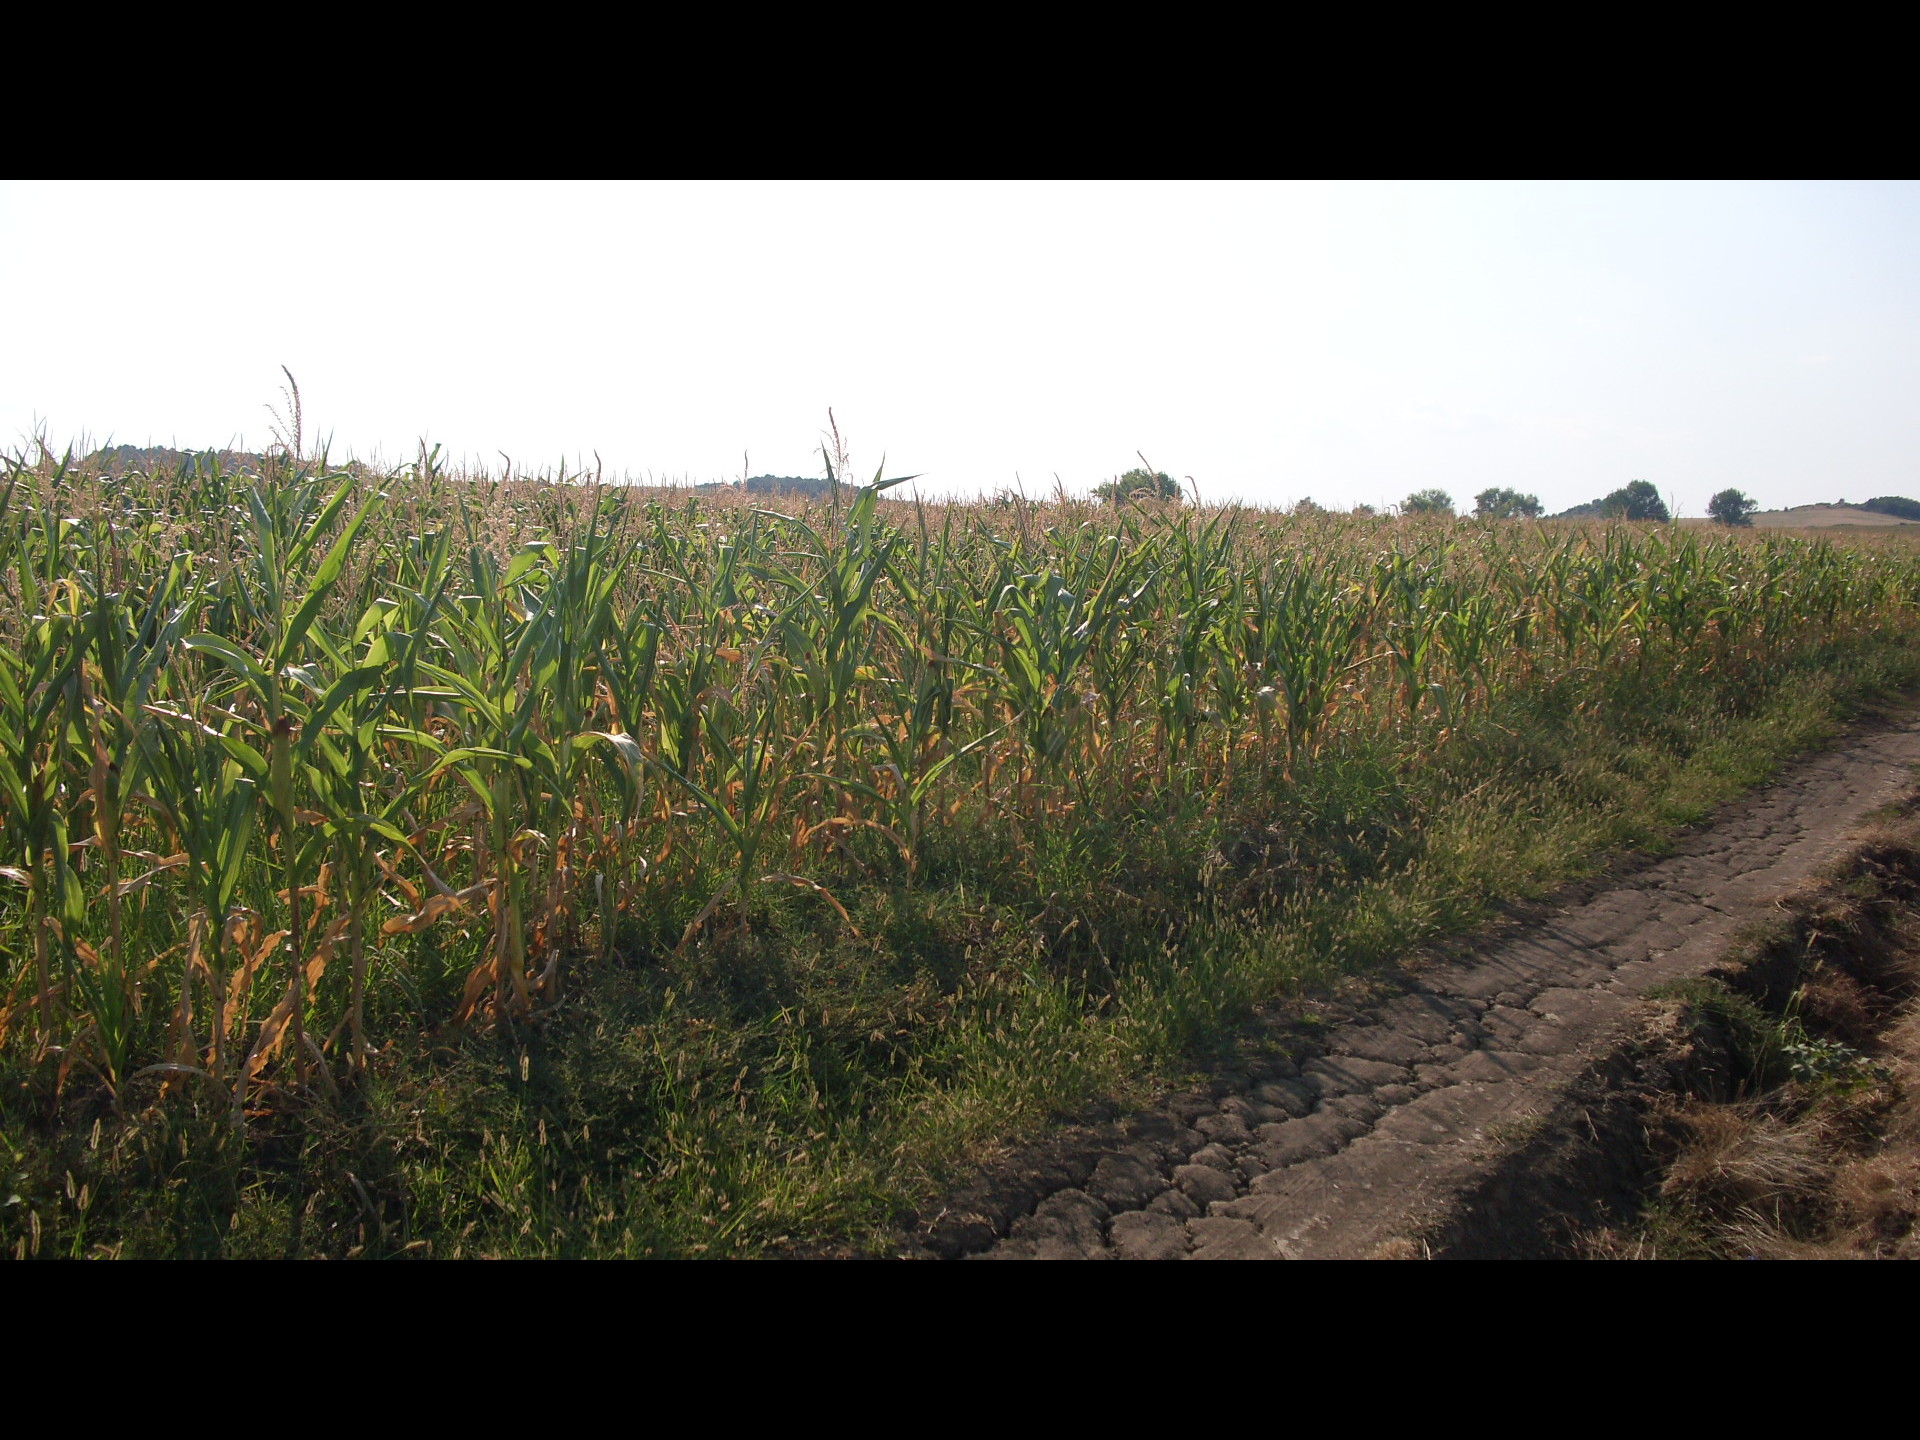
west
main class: Cropland
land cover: Sunflower
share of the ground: > 75 %
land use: Agriculture (excluding fallow land and kitchen gardens)
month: August
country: BG
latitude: 43.3633
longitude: 23.4308
